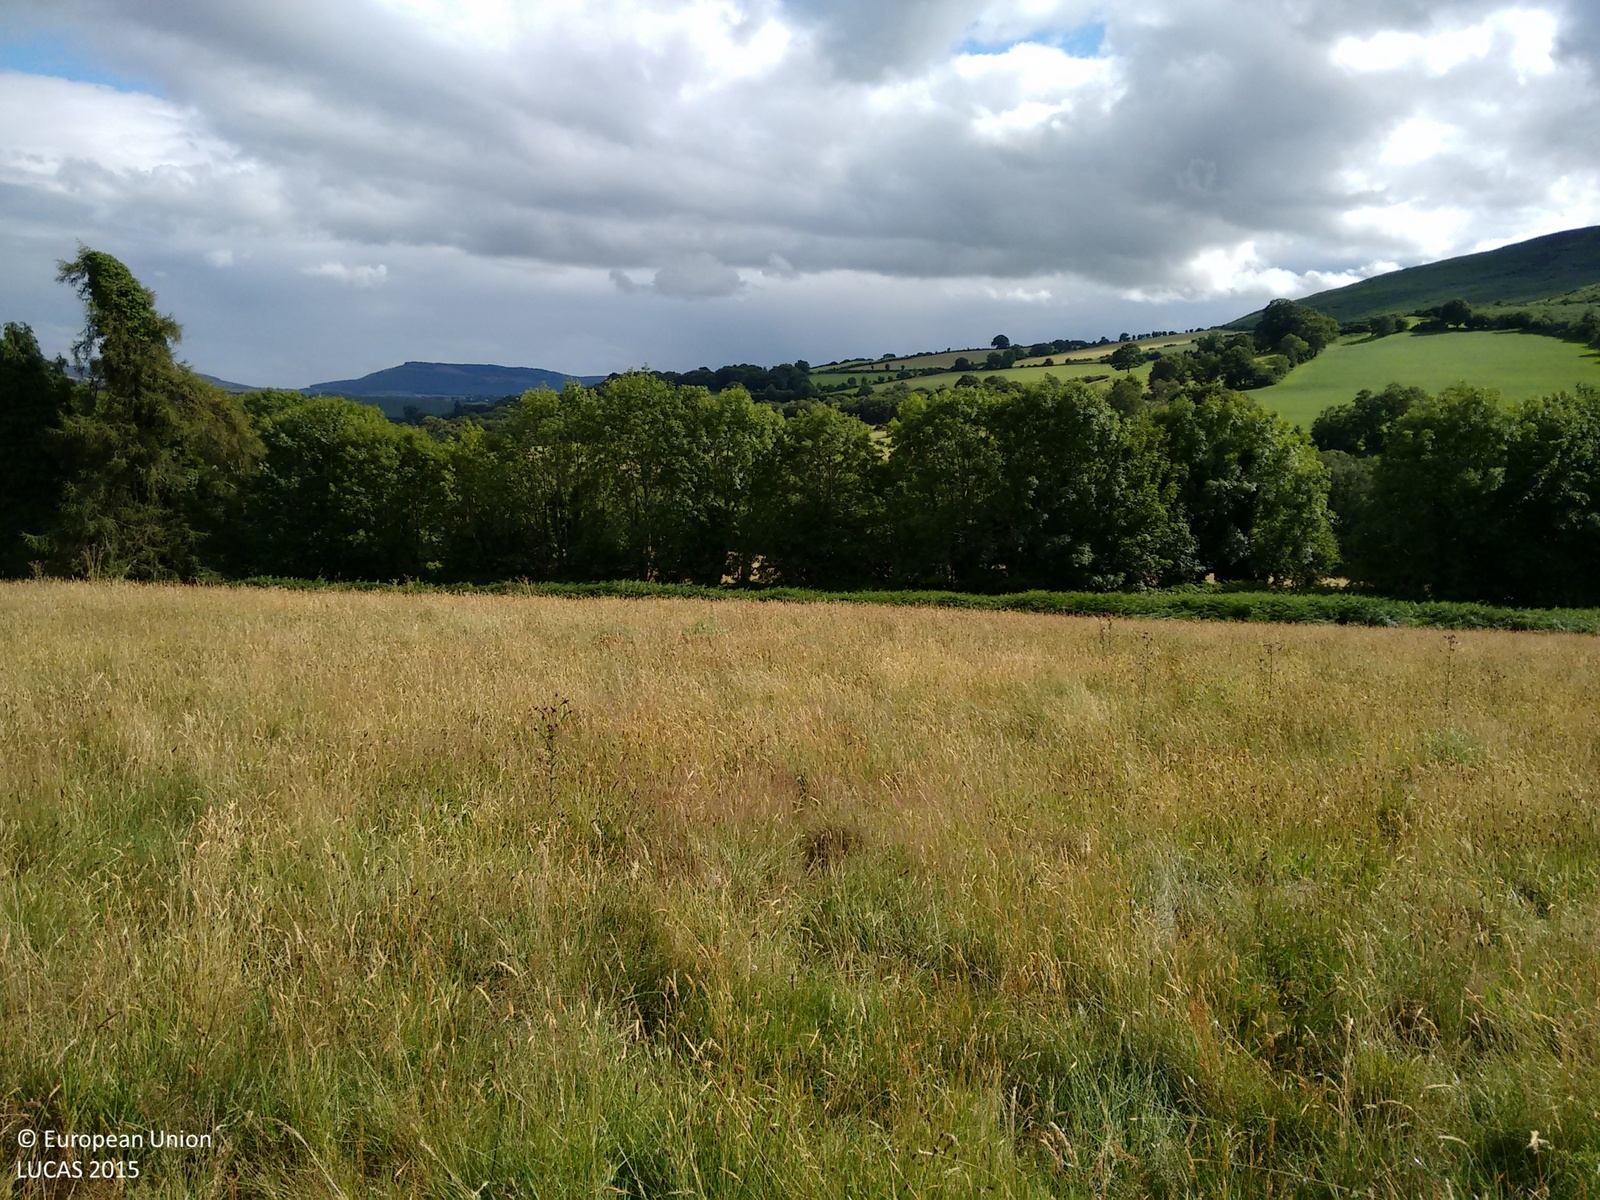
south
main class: Grassland
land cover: Grassland without tree/shrub cover
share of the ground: > 75 %
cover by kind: herbaceous plants 100 %
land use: Agriculture (excluding fallow land and kitchen gardens)
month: July
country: IE
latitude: 52.8365
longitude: -6.4399
